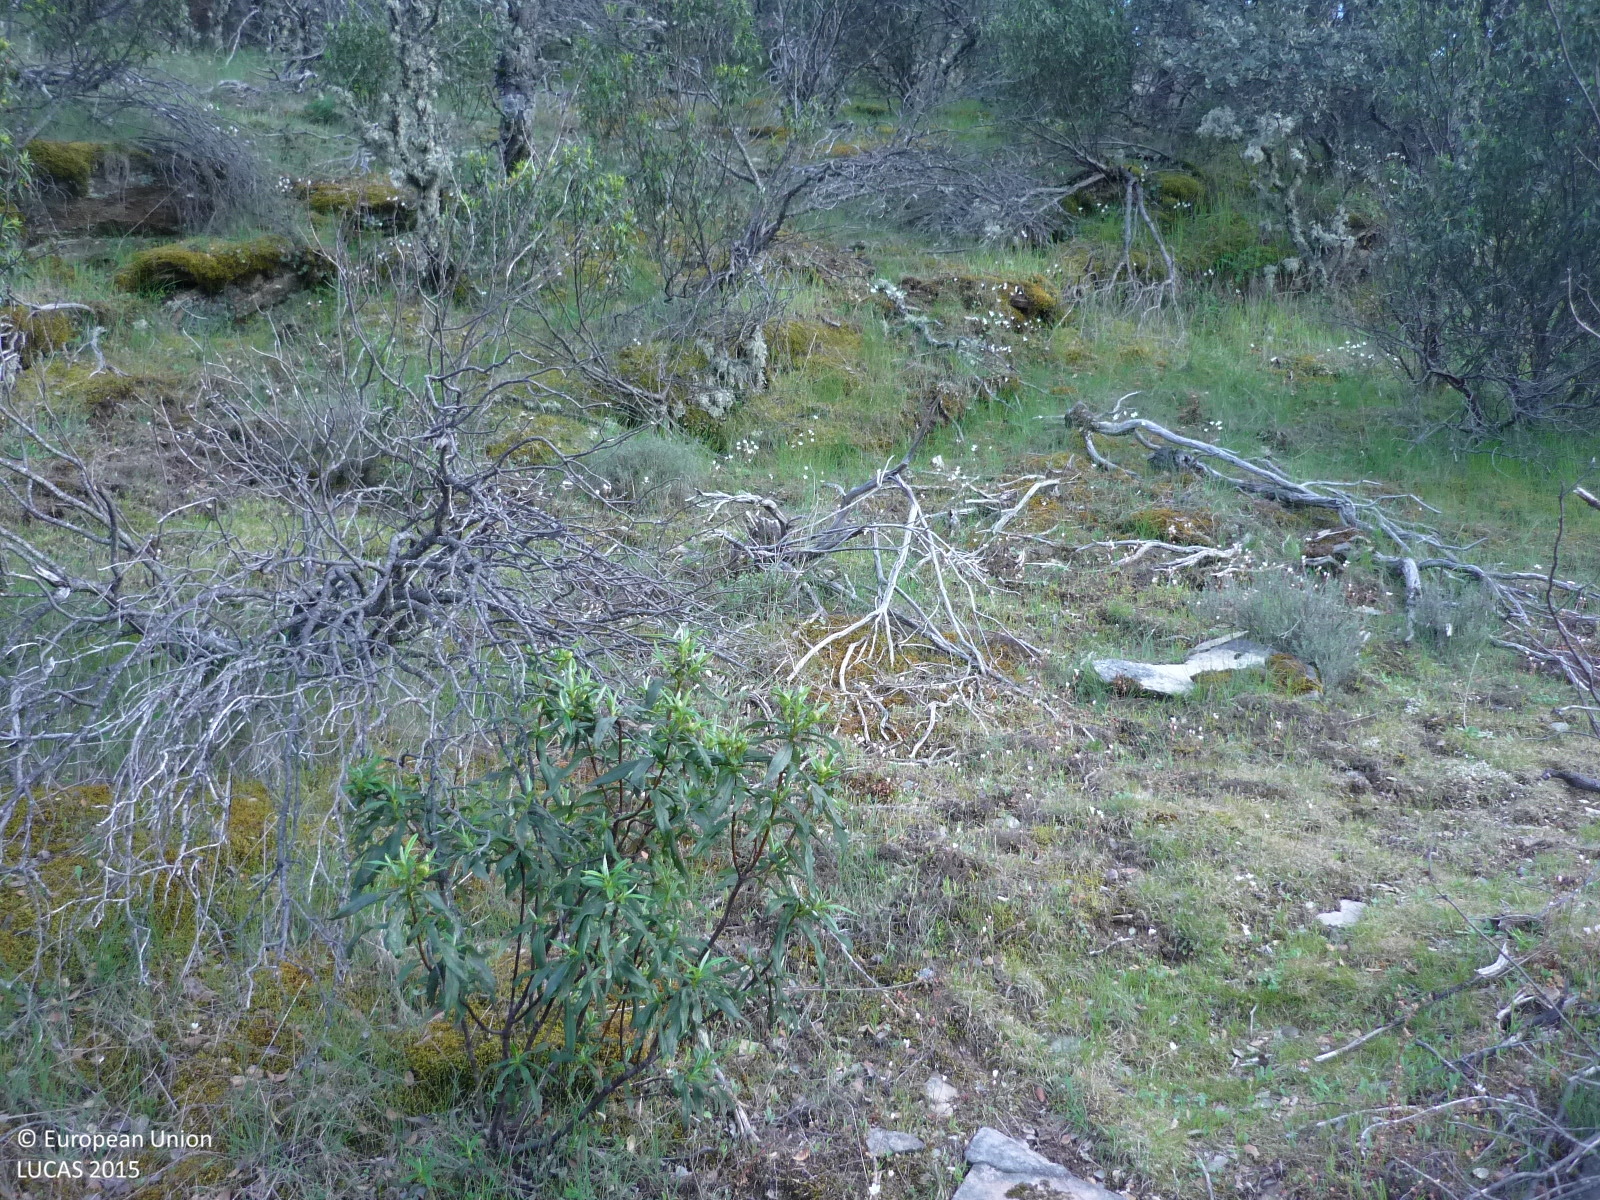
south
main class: Woodland
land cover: Broadleaved woodland
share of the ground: 50 - 75 %
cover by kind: broadleaved forest trees 50 %, herbaceous plants 30 %, shrubs 20 %
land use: Semi-natural and natural areas not in use
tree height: < 5 m
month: April
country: ES
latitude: 40.9877
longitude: -3.5575
